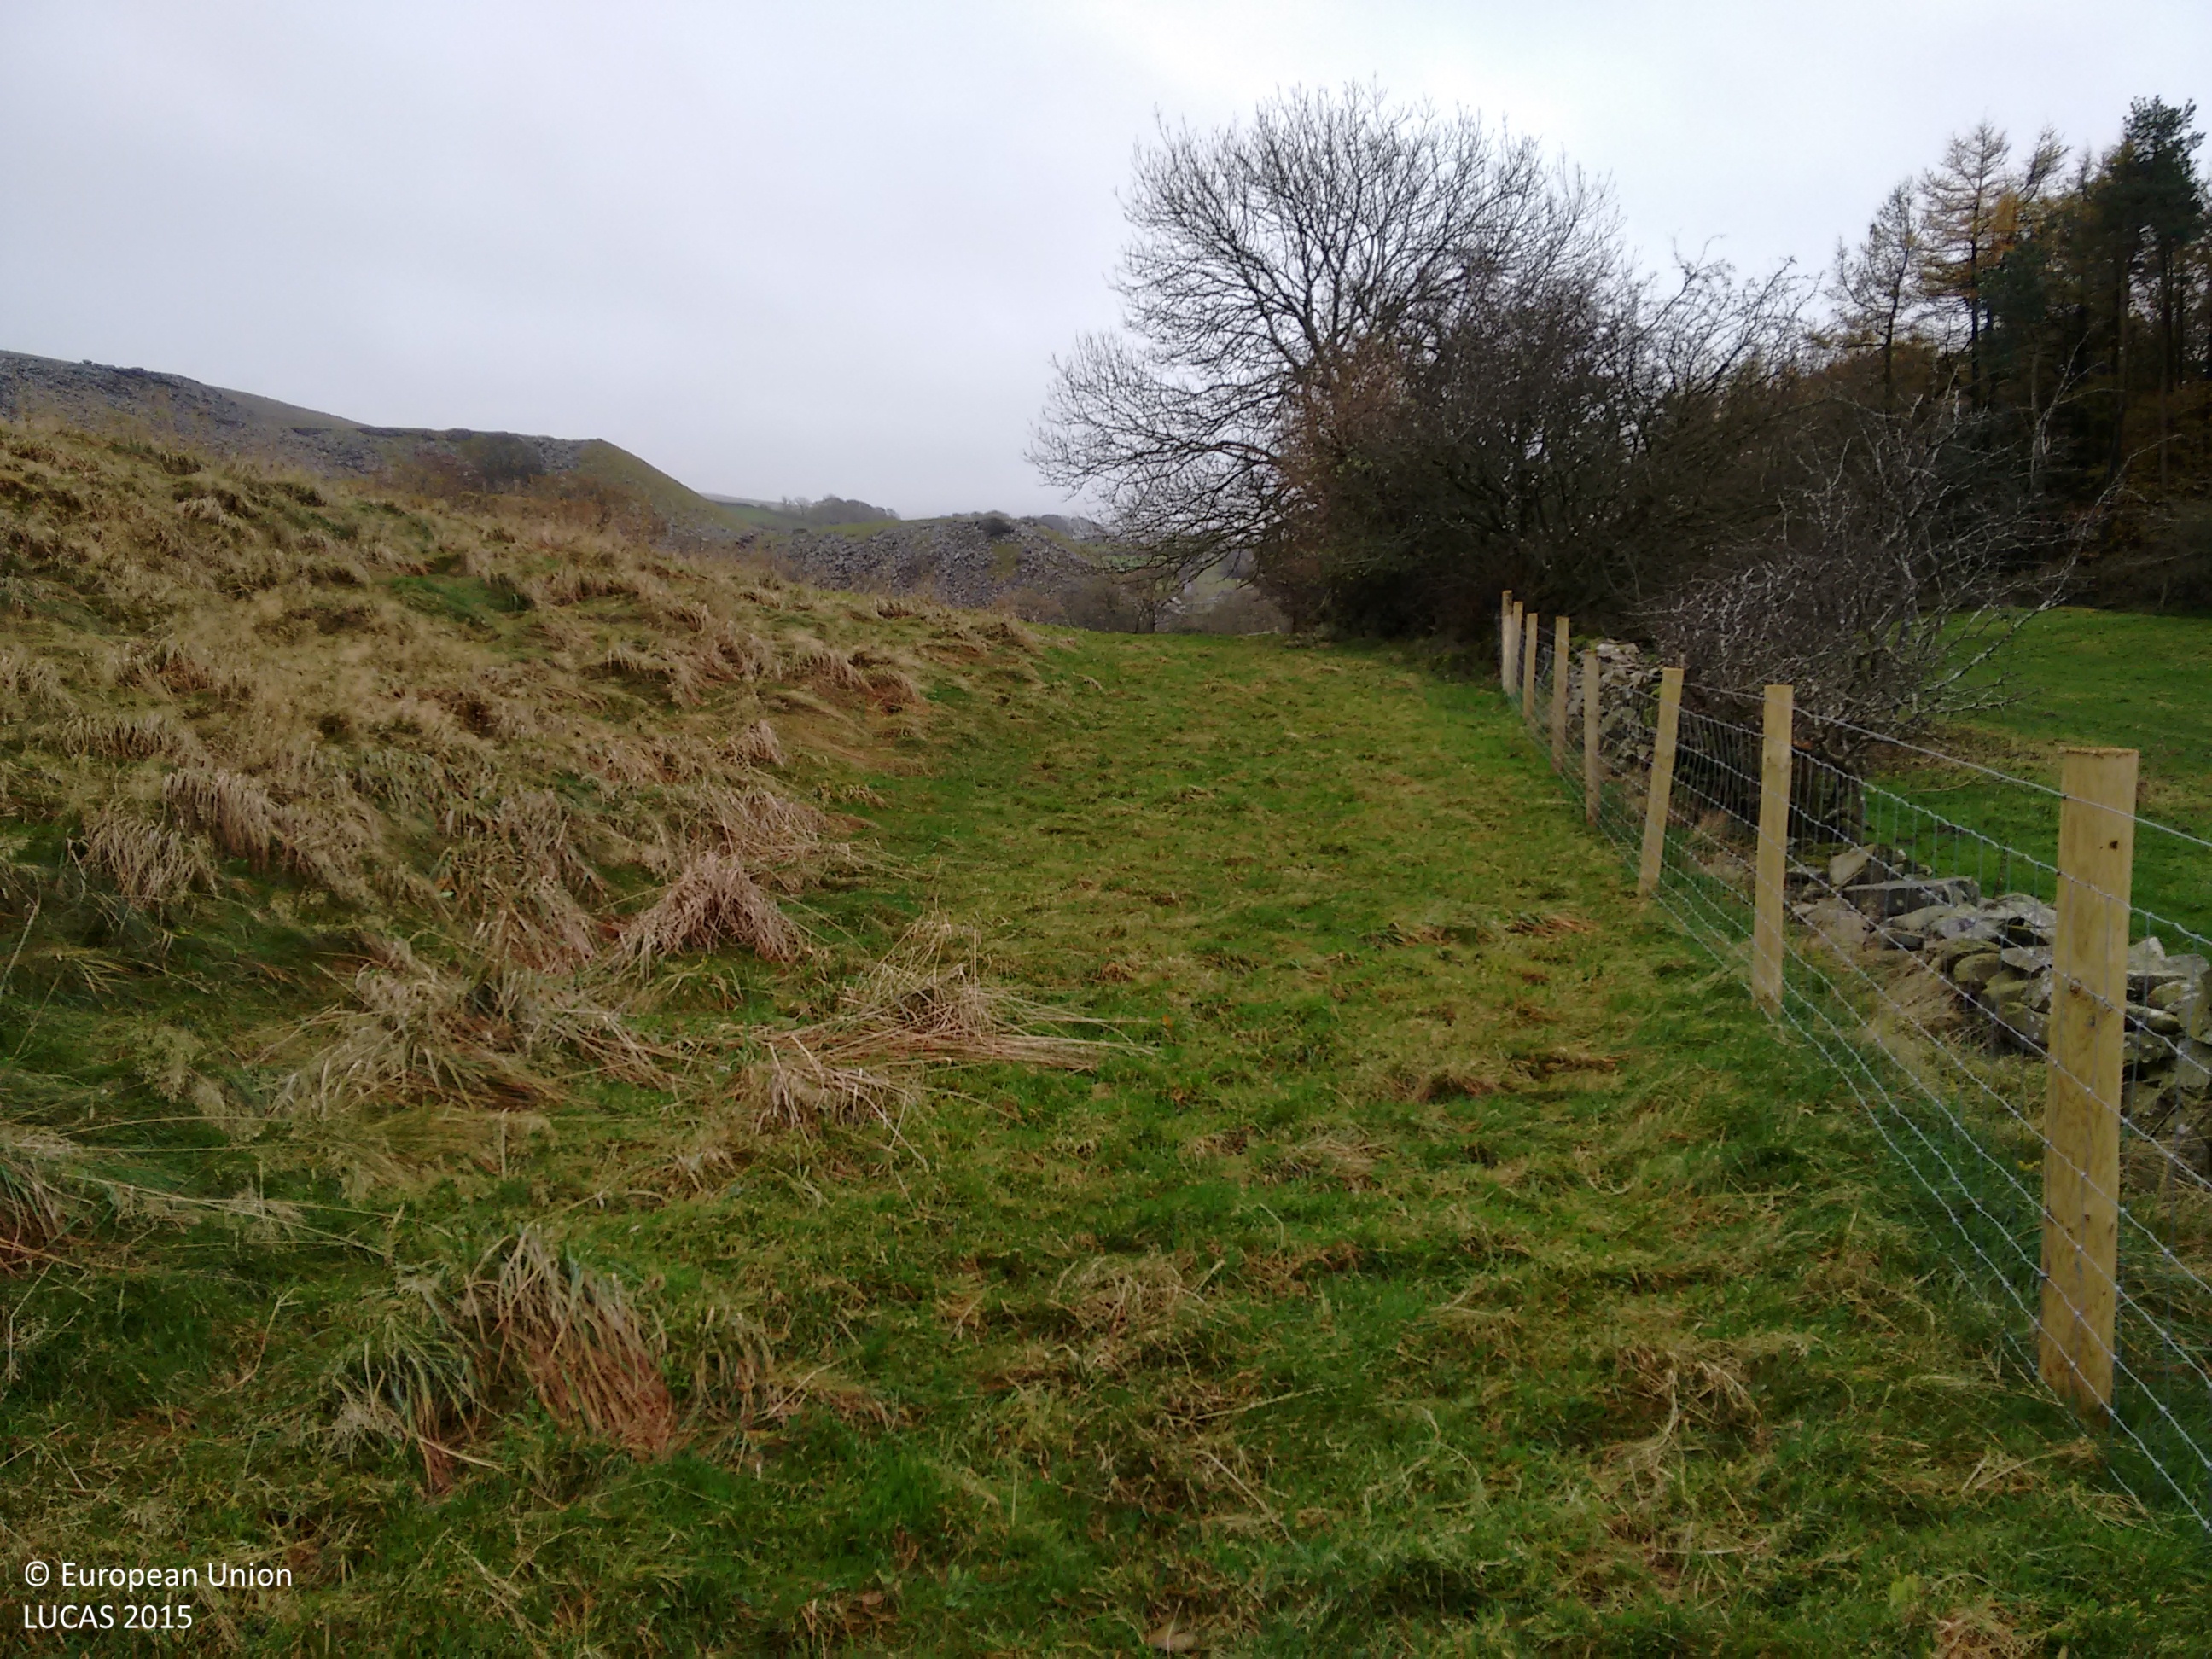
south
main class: Grassland
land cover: Grassland without tree/shrub cover
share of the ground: > 75 %
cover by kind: herbaceous plants 100 %
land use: Agriculture (excluding fallow land and kitchen gardens)
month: November
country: GB
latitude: 54.2468
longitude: -3.1667
